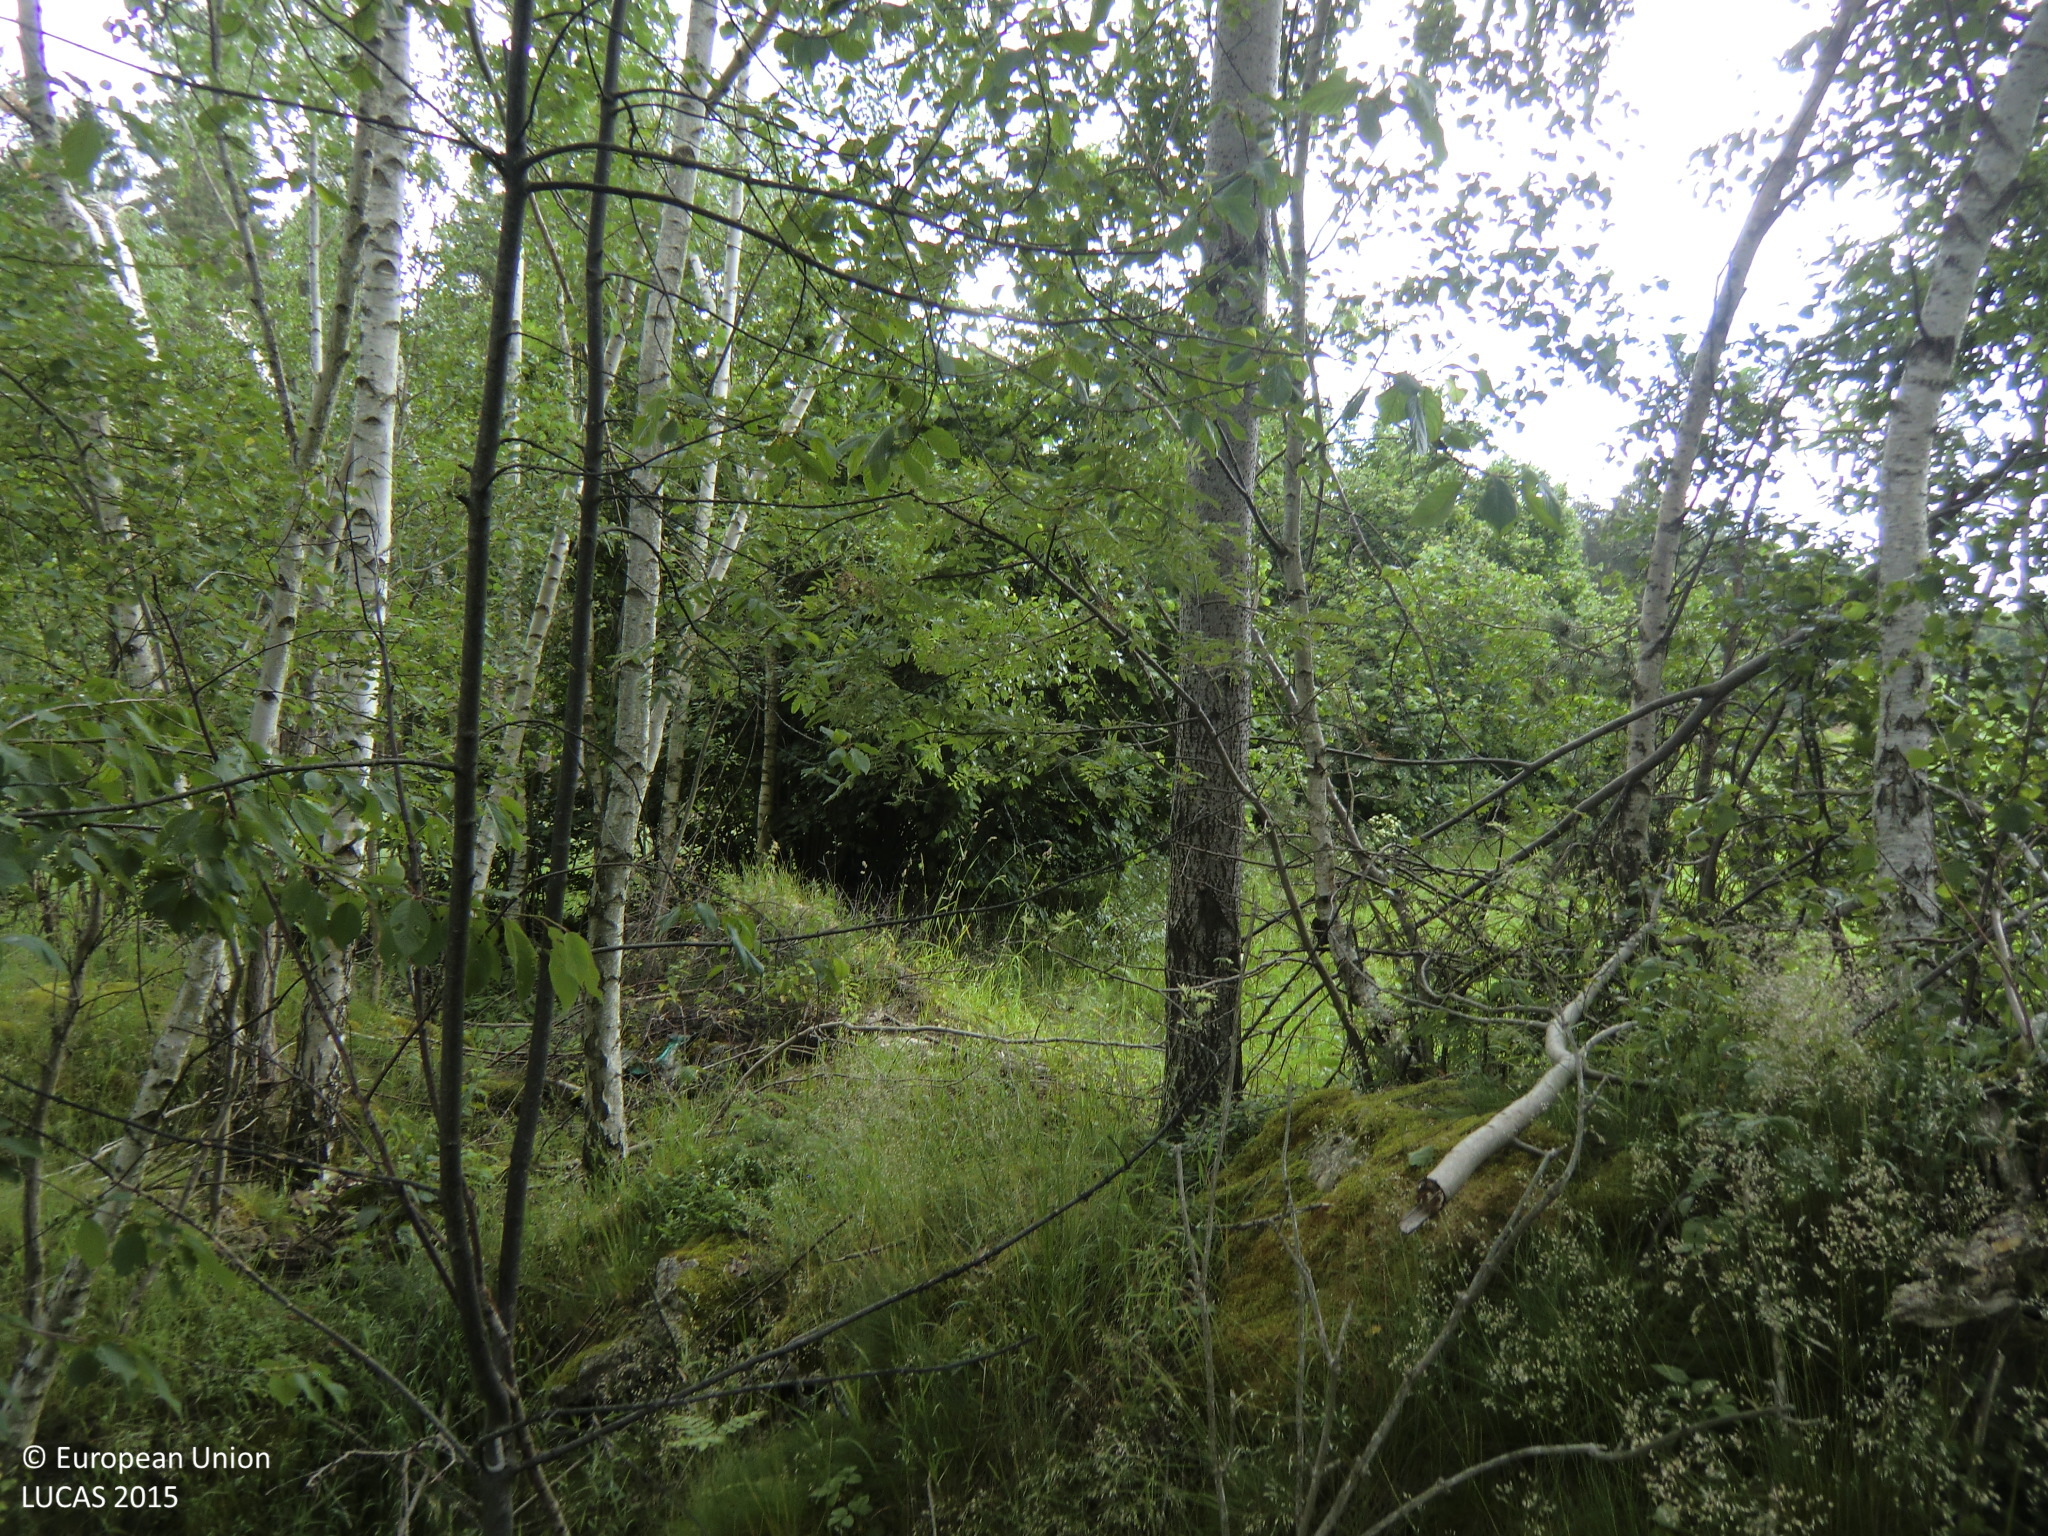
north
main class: Woodland
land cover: Broadleaved woodland
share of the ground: > 75 %
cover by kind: broadleaved forest trees 85 %, herbaceous plants 5 %, lichens and mosses 5 %, consolidated bare surface 5 %
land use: Forestry
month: June
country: AT
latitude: 48.5249
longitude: 14.9980
